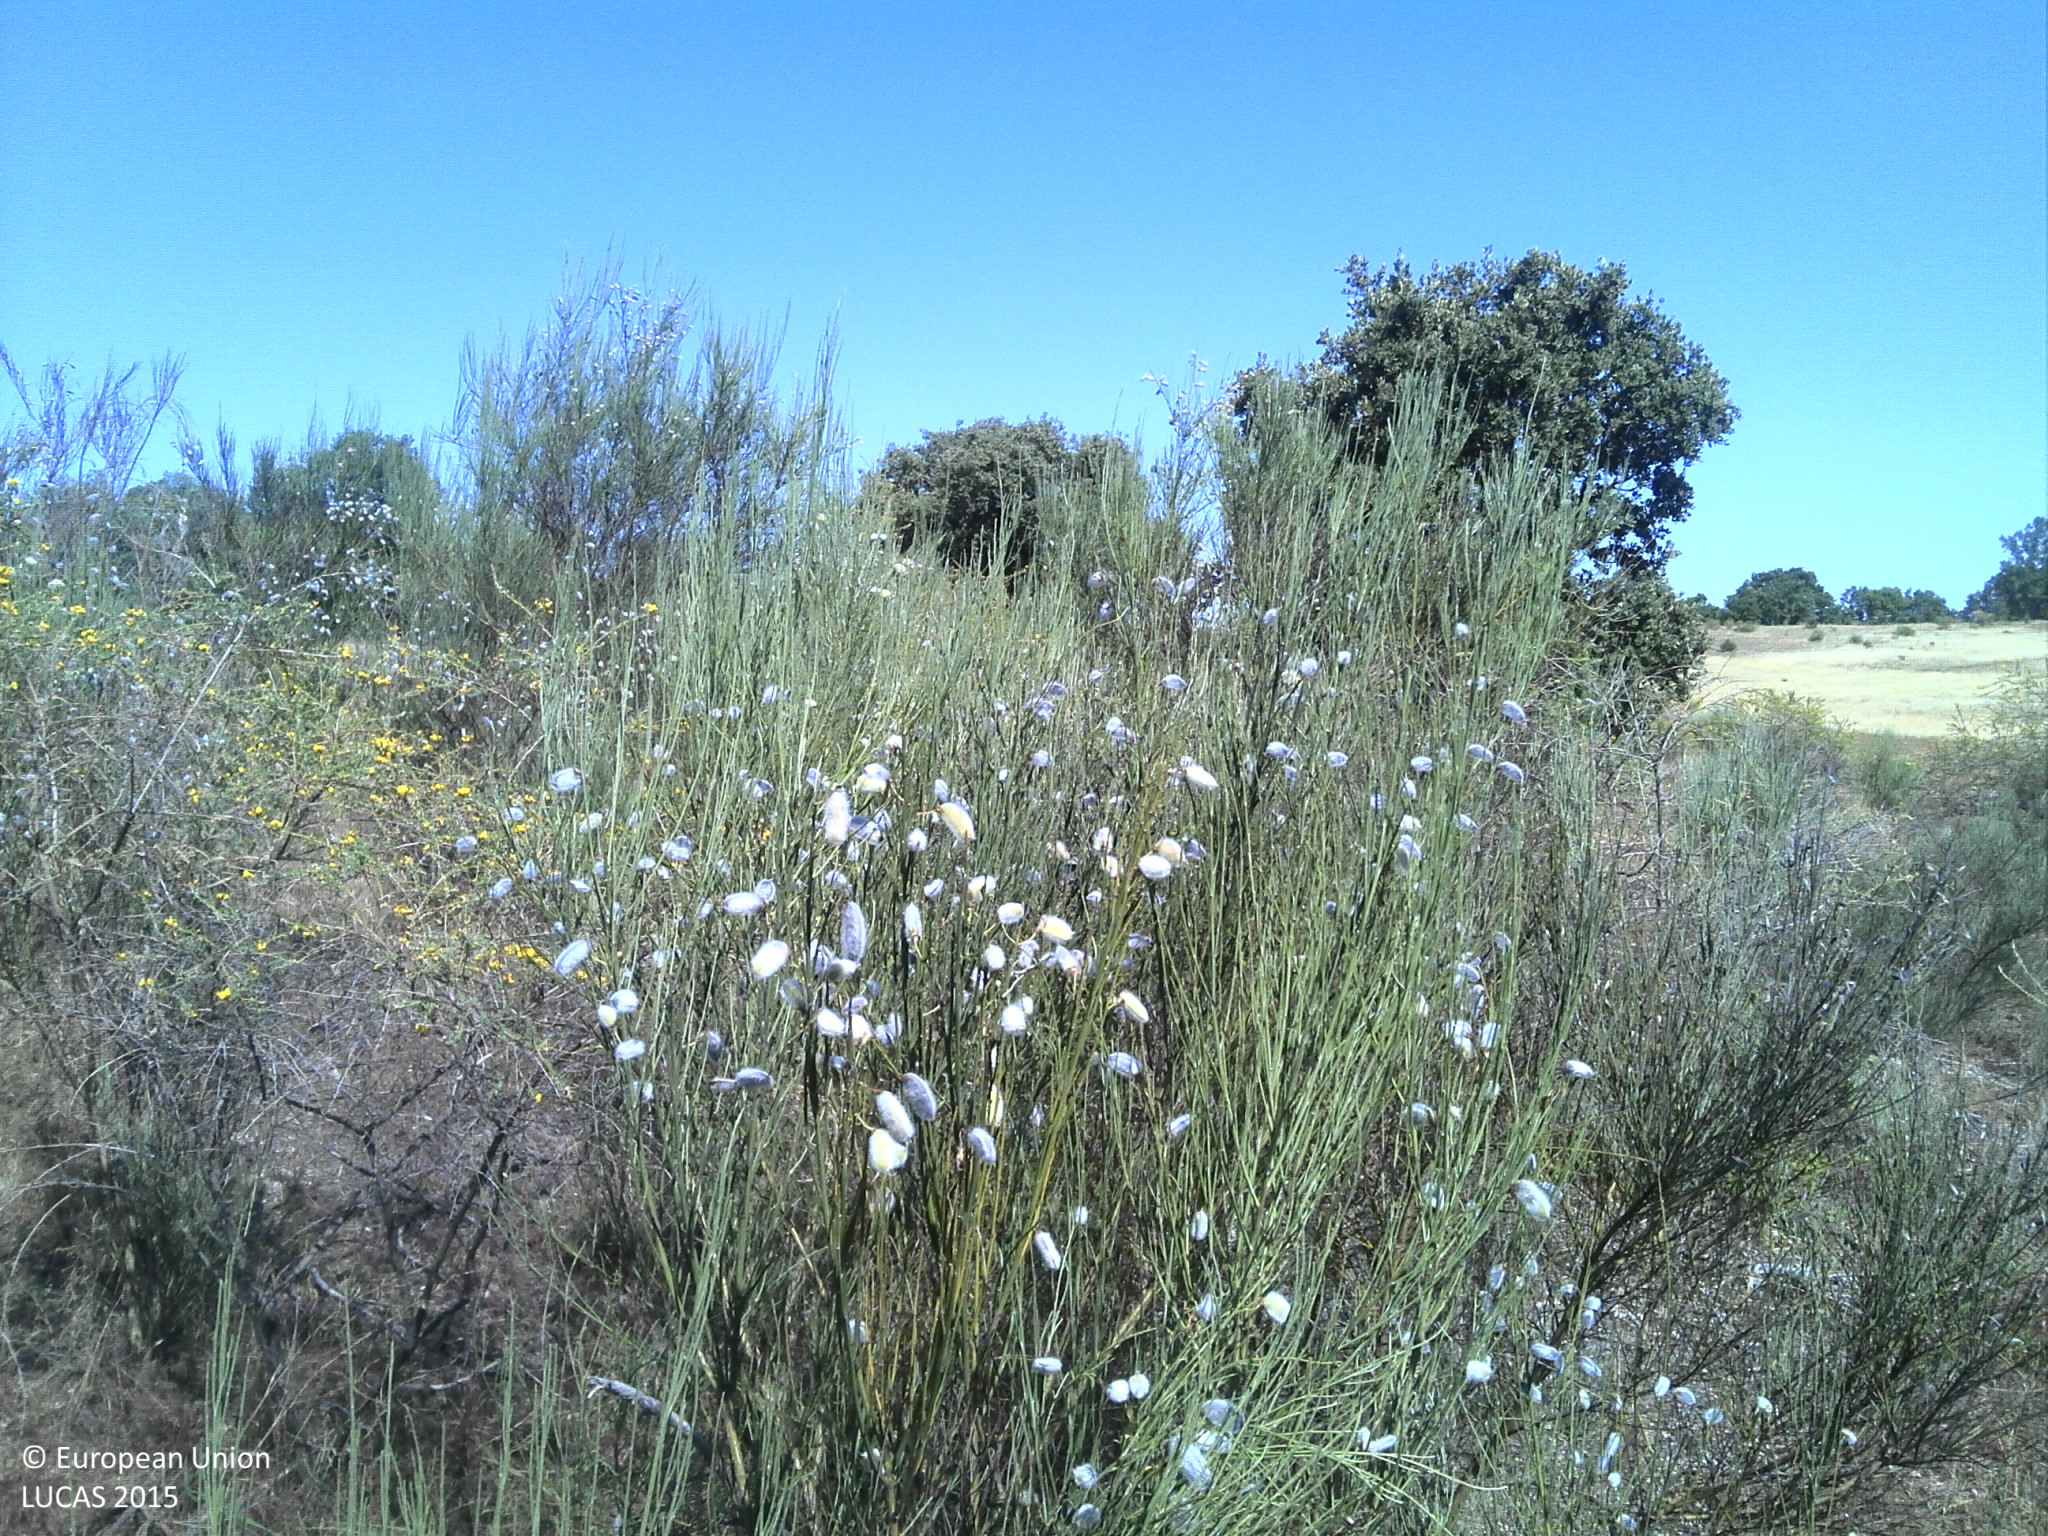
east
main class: Shrubland
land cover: Shrubland without tree cover
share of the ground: 25 - 50 %
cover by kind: shrubs 50 %, consolidated bare surface 30 %, unconsolidated bare surface 20 %
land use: Abandoned areas
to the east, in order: Shrubland without tree cover; Grassland without tree/shrub cover; Shrubland without tree cover; Tracks; Olive groves; Grassland without tree/shrub cover; Electric lines; Abandoned hedges; Inland fresh water bodies
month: June
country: PT
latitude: 40.0480
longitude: -7.3897
